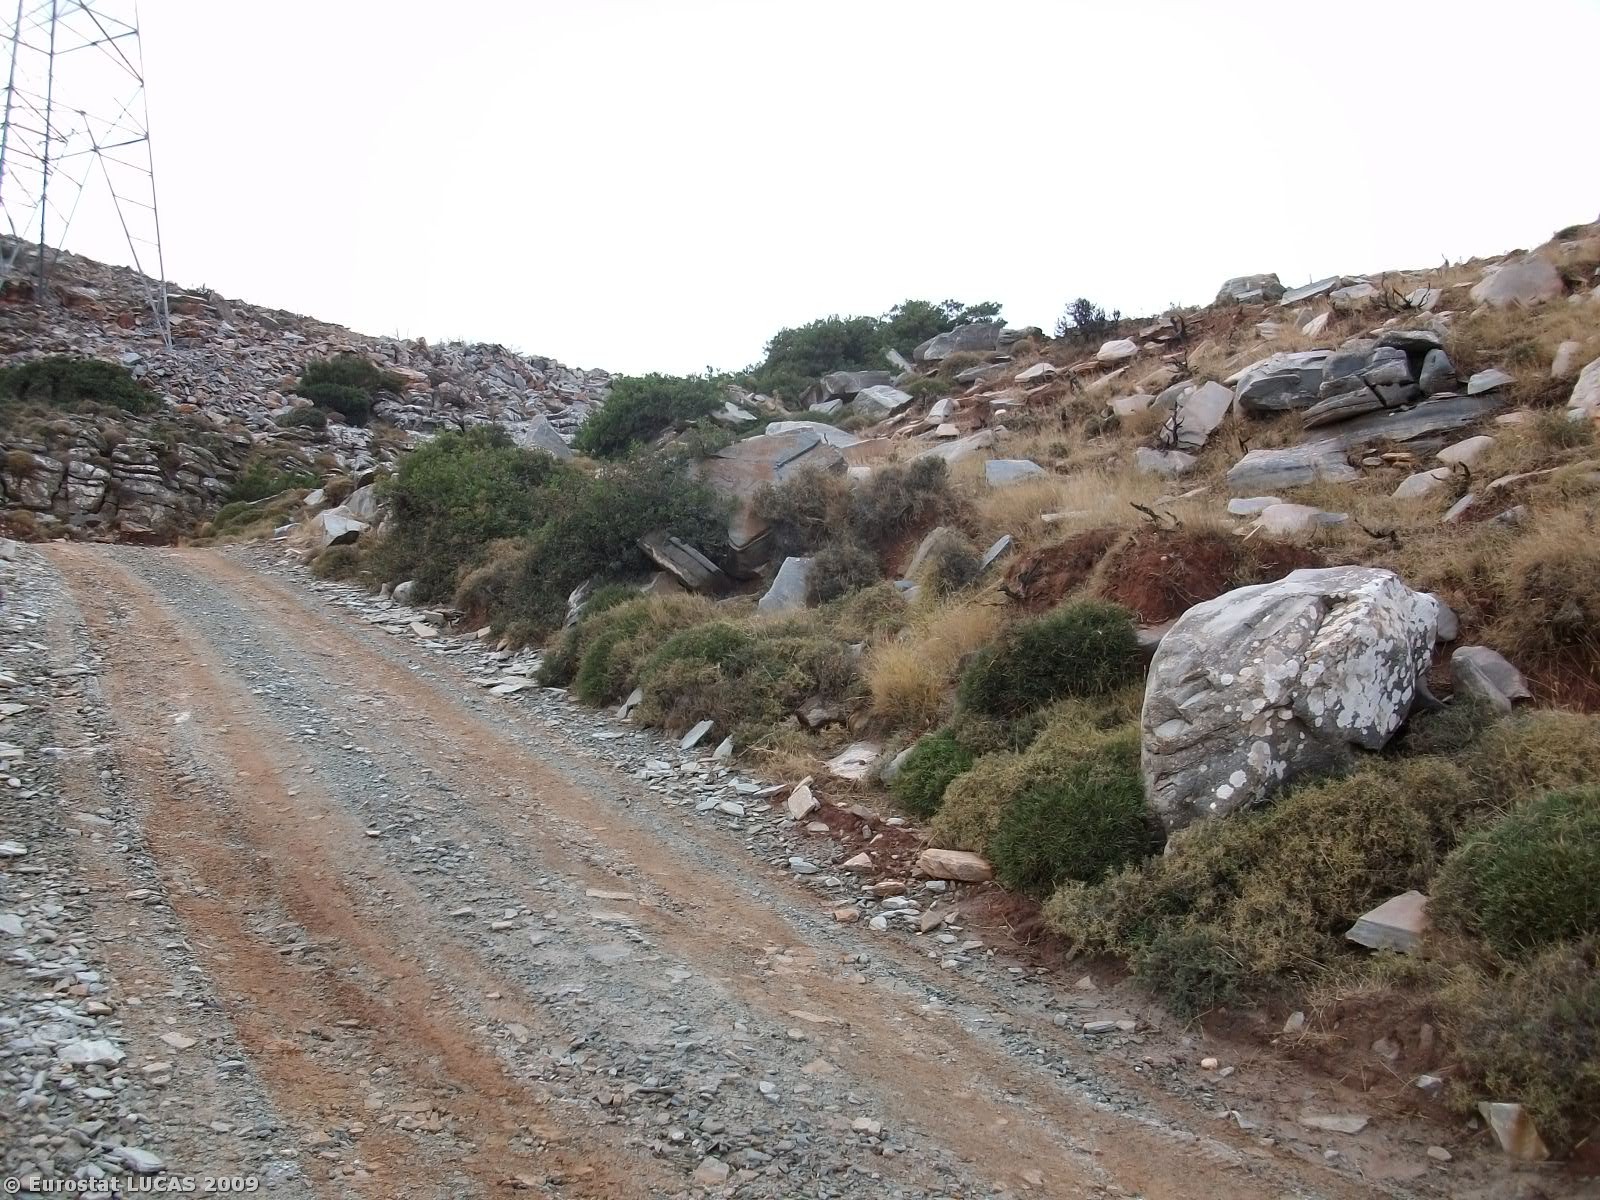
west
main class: Shrubland
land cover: Shrubland without tree cover
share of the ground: > 75 %
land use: Unused
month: September
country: GR
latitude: 38.1188
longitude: 24.2581
